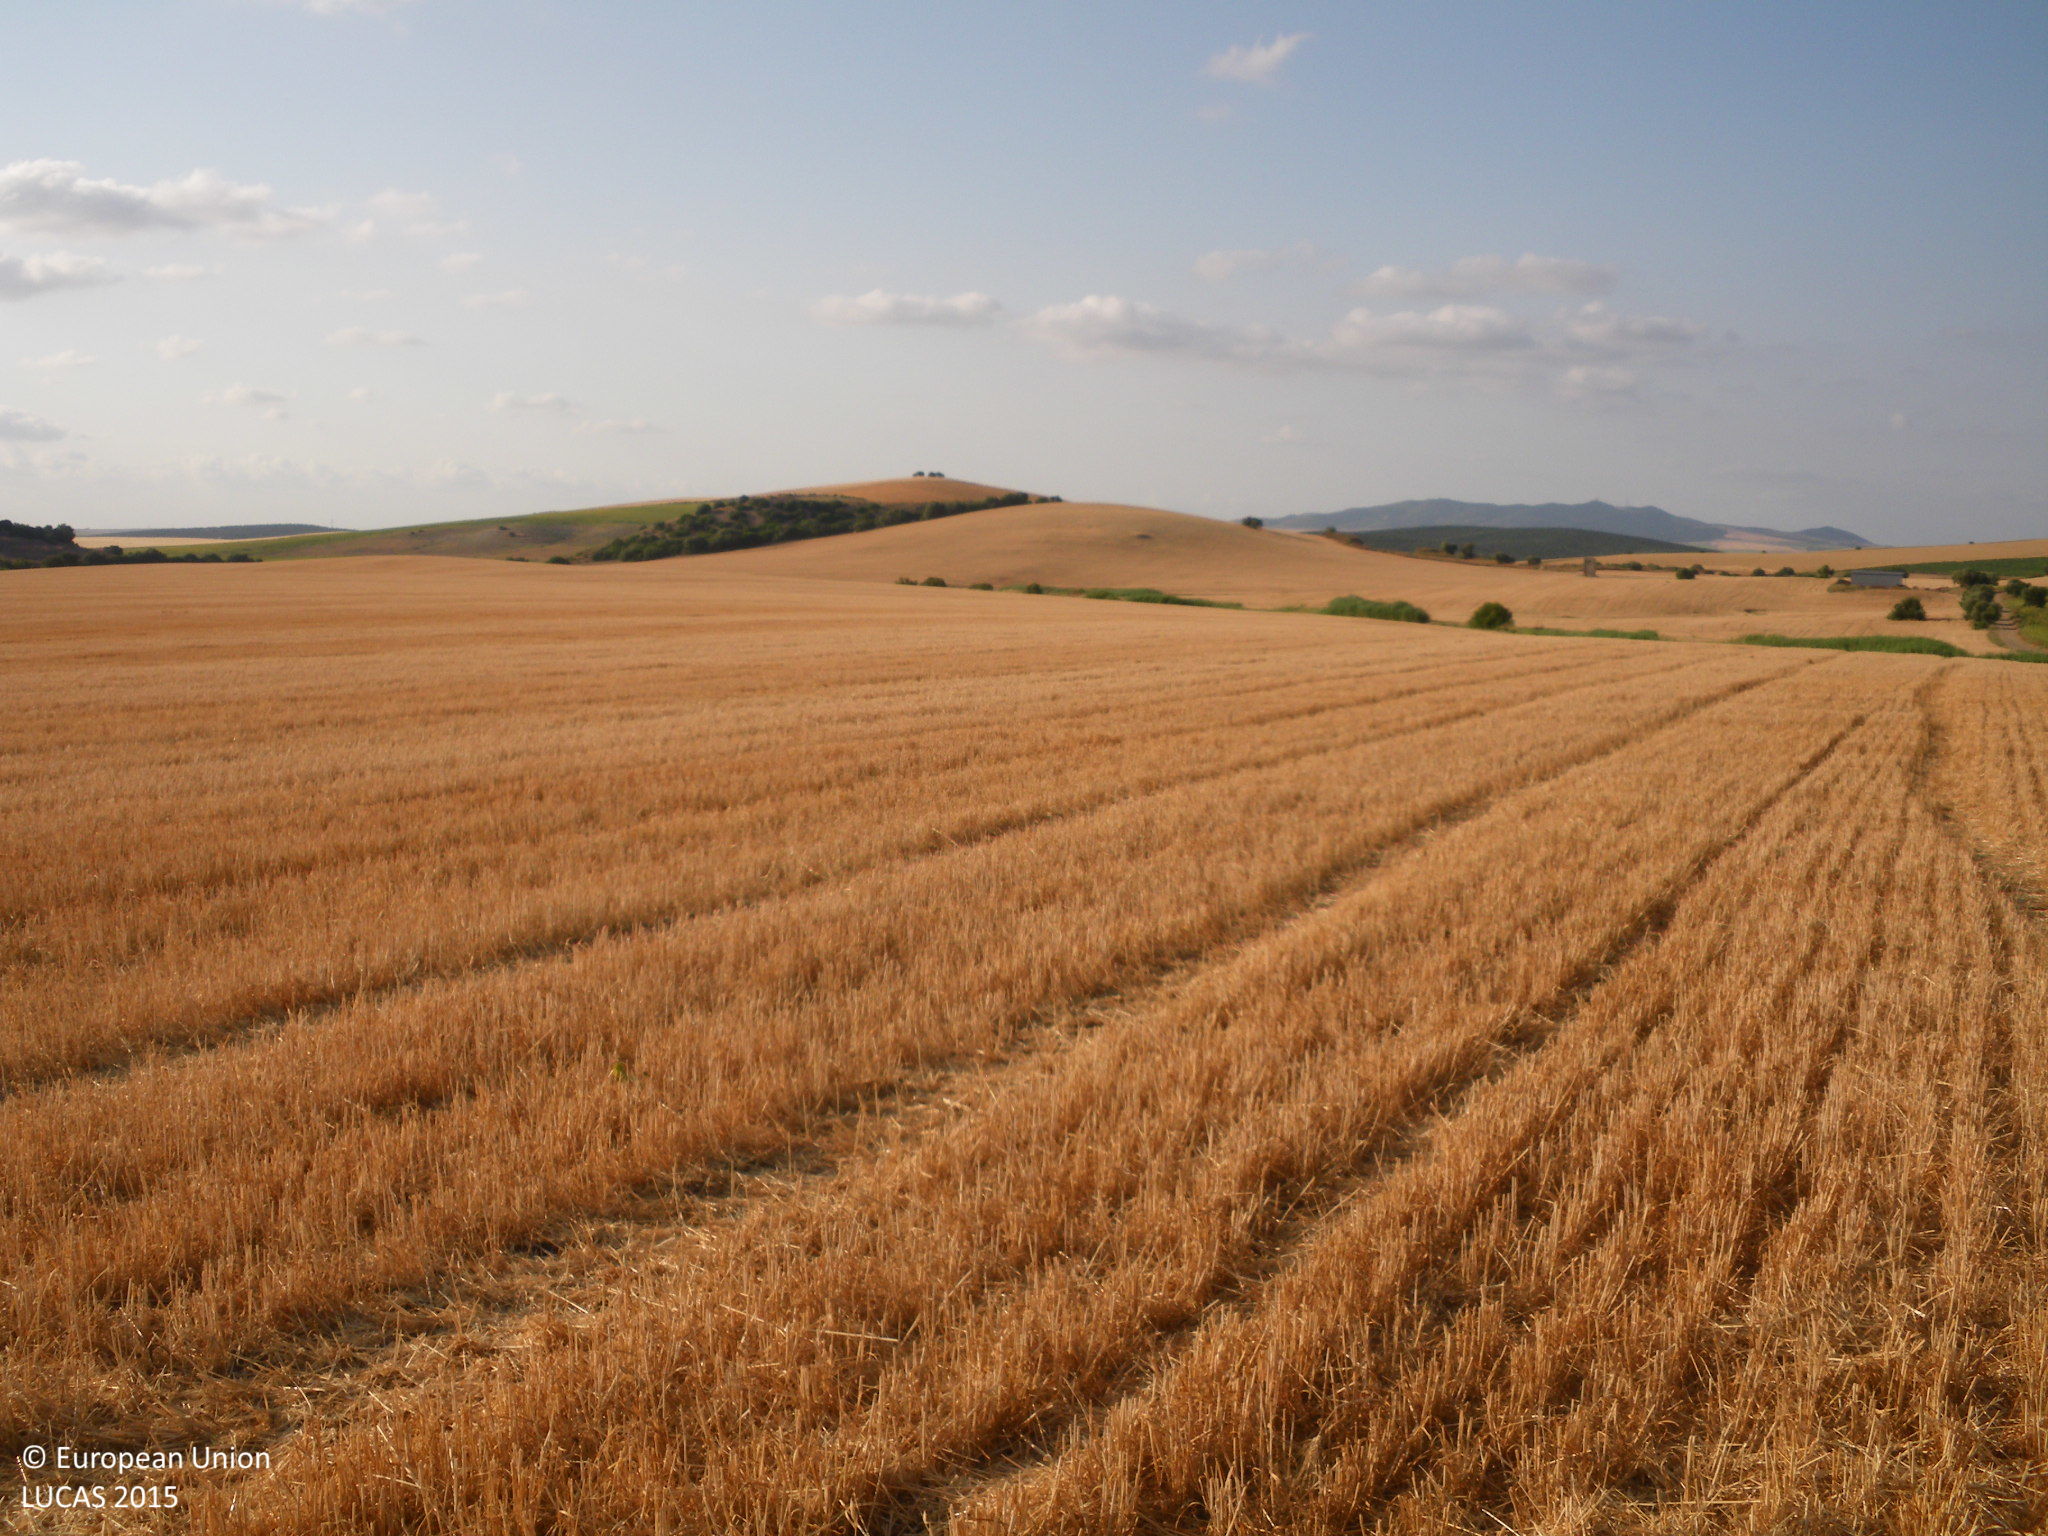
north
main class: Cropland
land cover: Durum wheat
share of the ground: < 10 %
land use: Agriculture (excluding fallow land and kitchen gardens)
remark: Harvested field
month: June
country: ES
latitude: 36.7175
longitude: -5.9868
